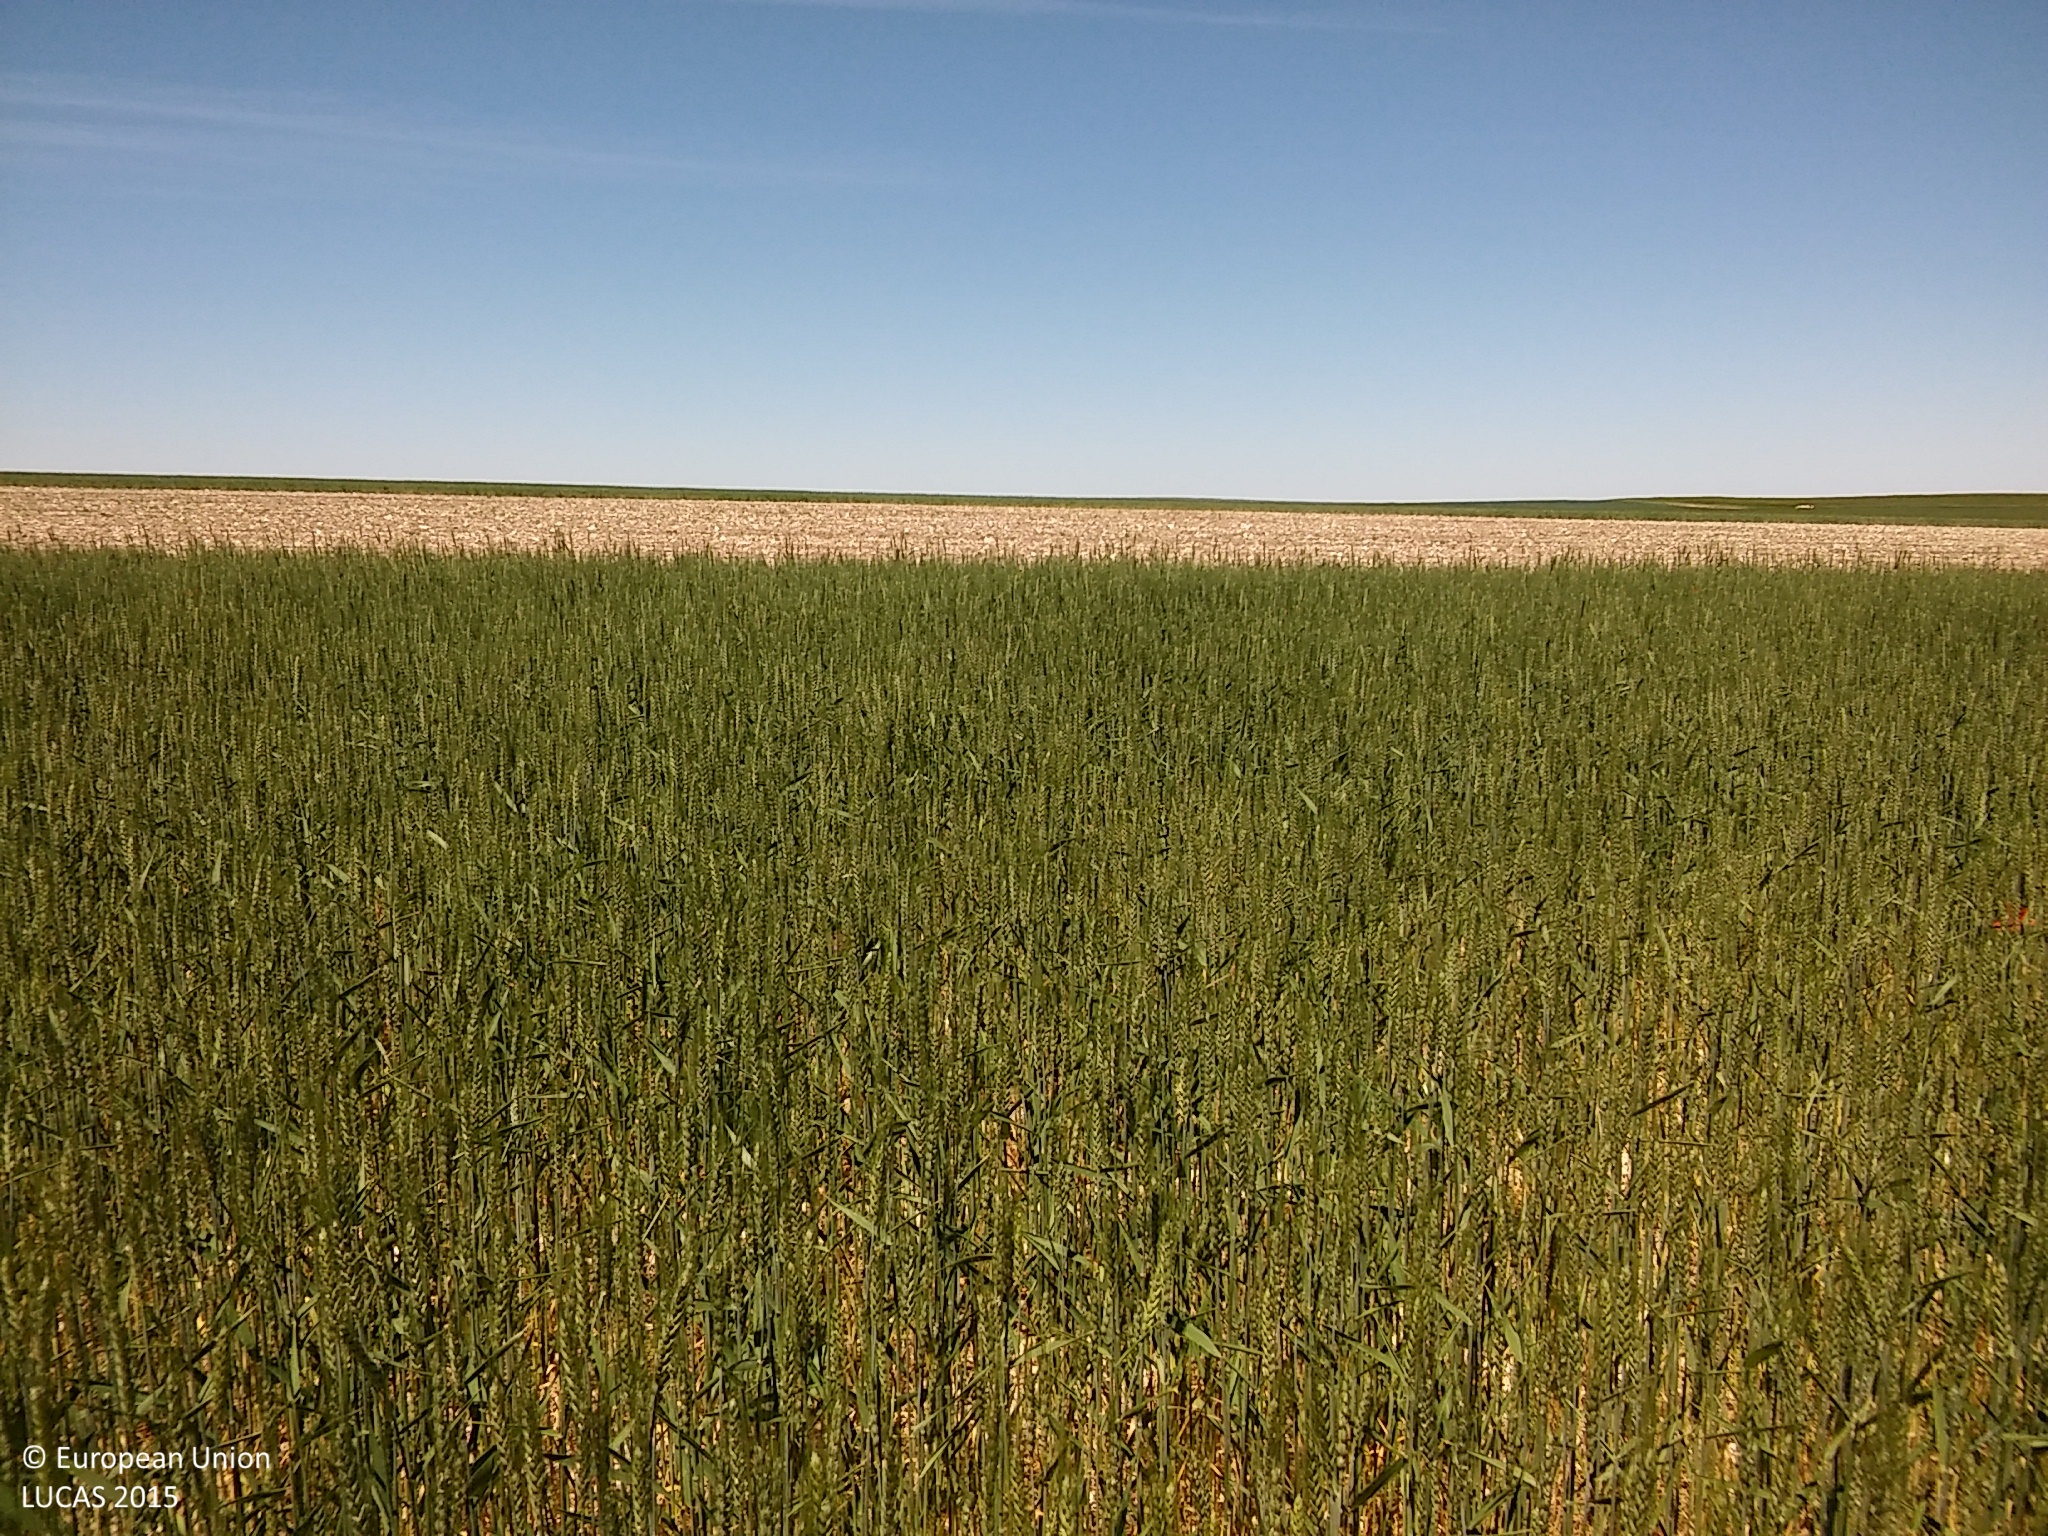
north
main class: Cropland
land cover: Common wheat
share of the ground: > 75 %
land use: Agriculture (excluding fallow land and kitchen gardens)
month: May
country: ES
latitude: 41.4708
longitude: -4.0292
